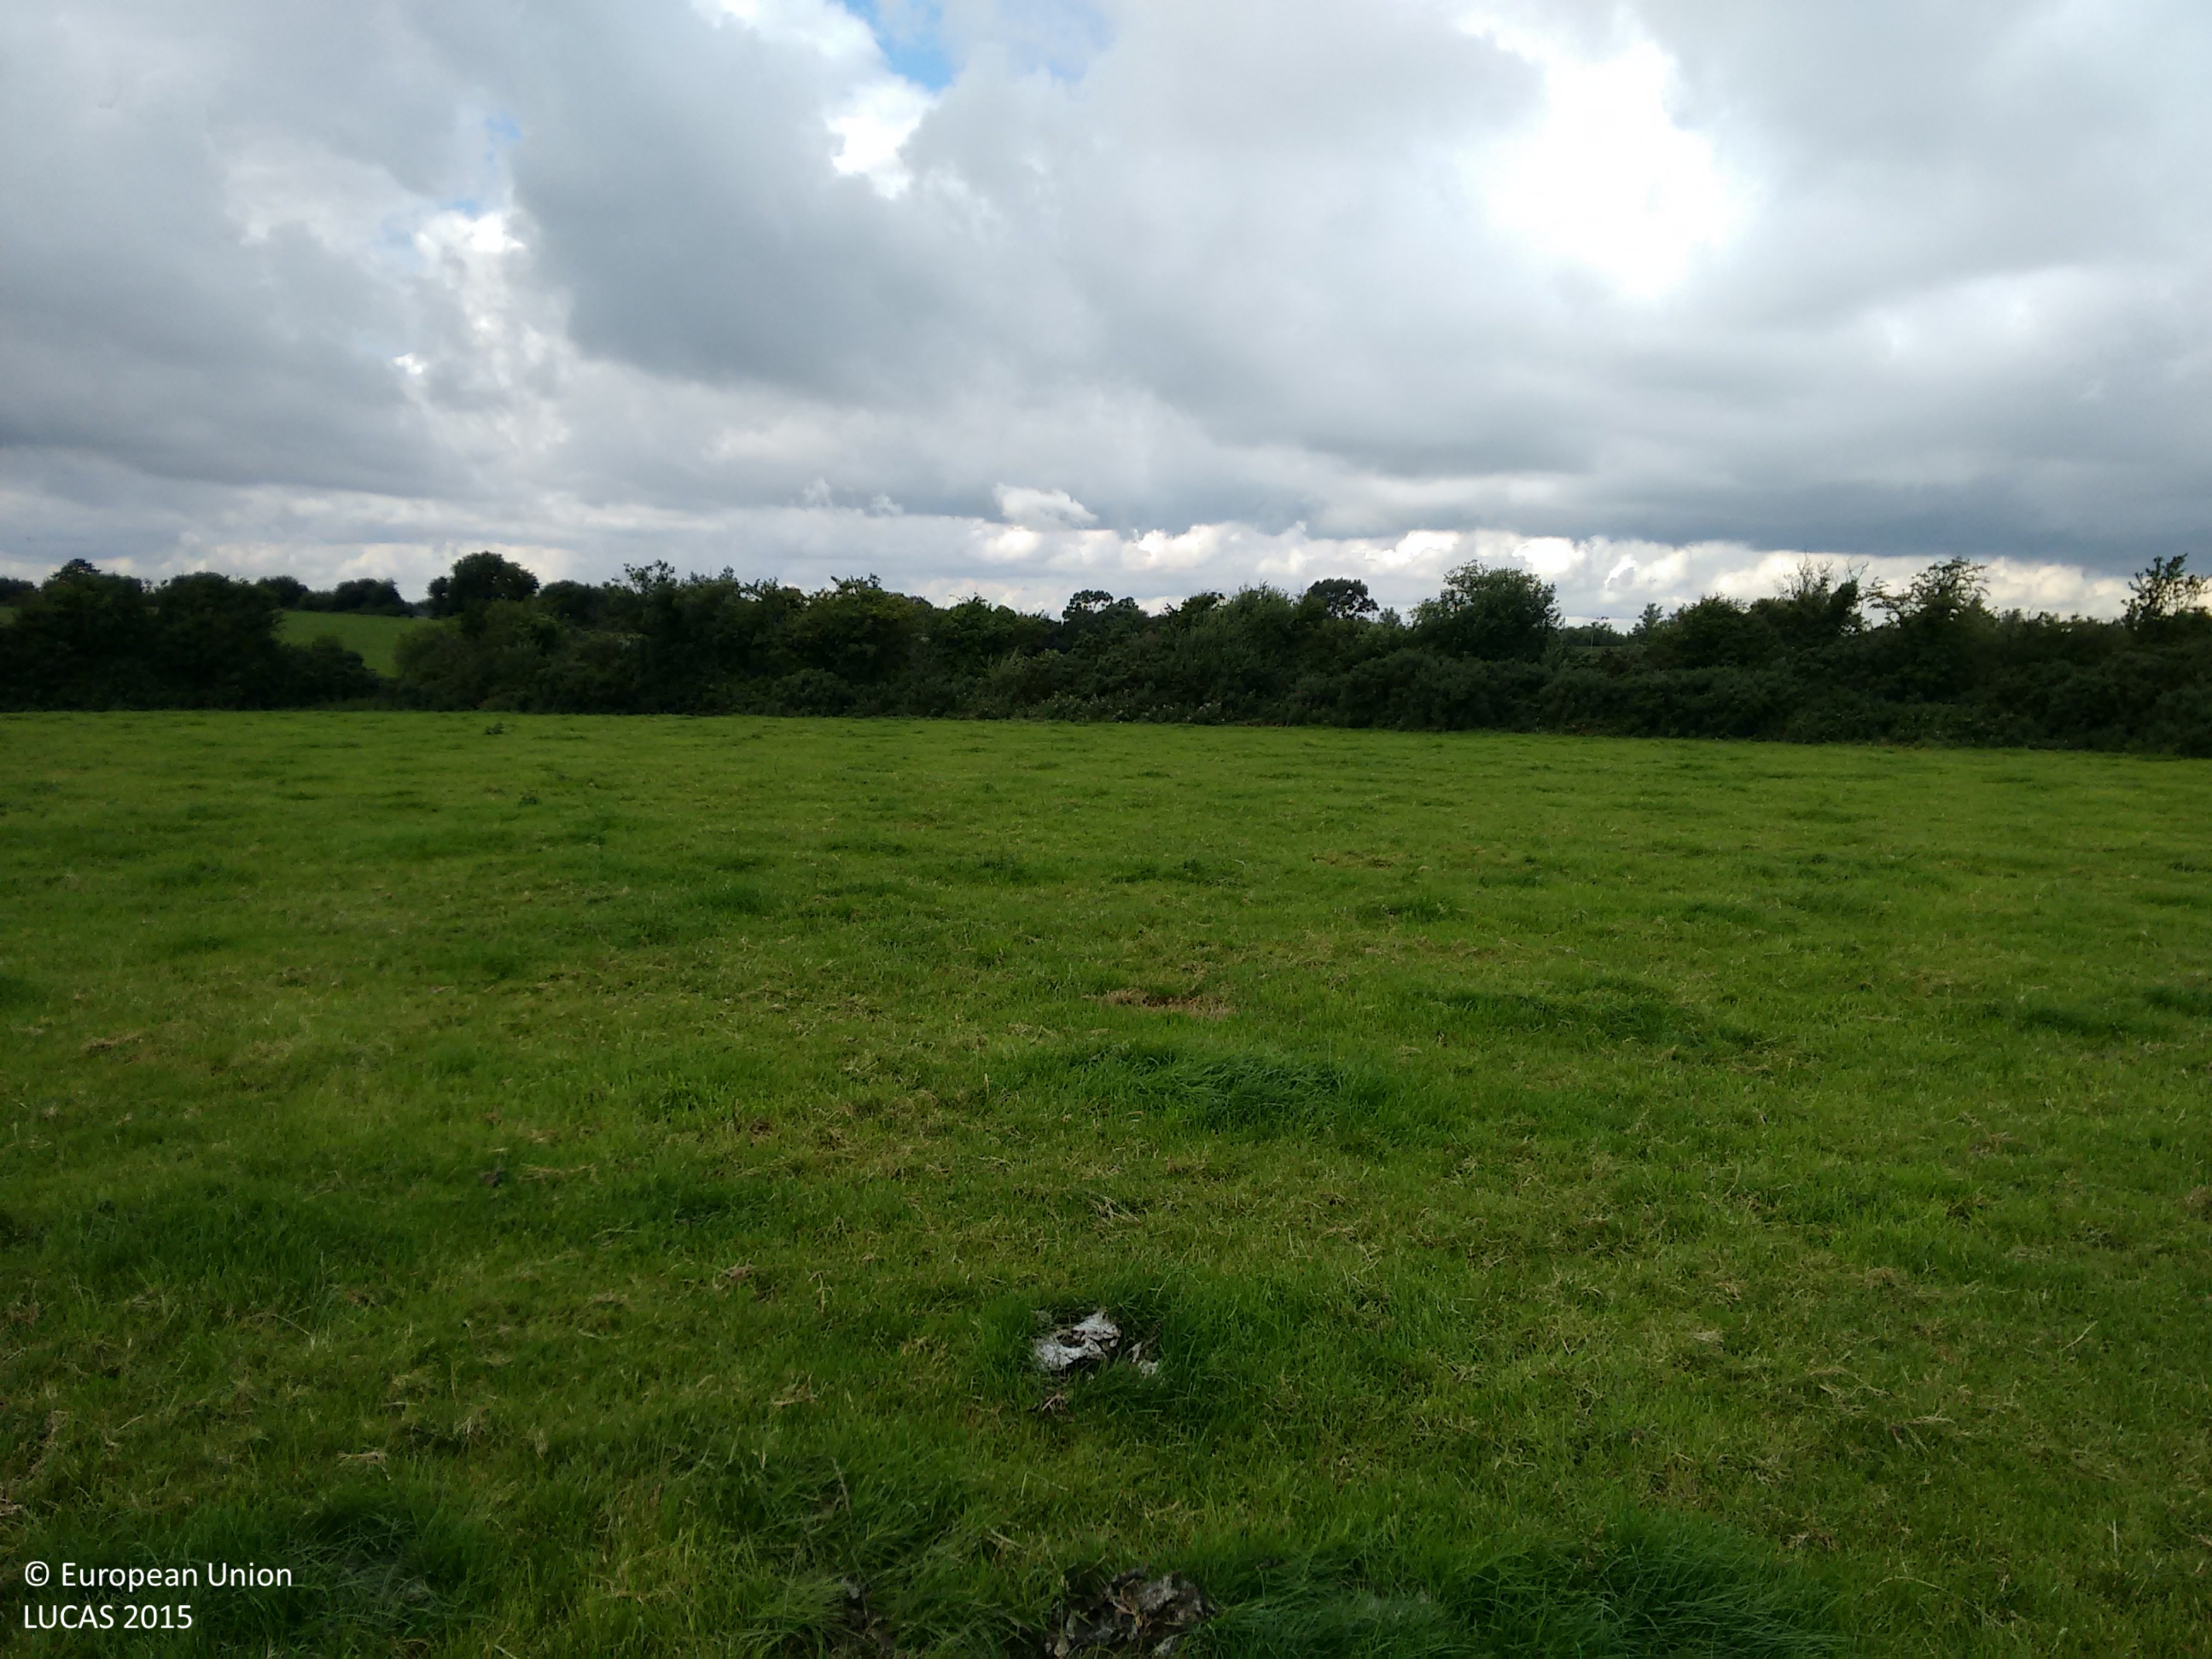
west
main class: Grassland
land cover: Grassland without tree/shrub cover
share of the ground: > 75 %
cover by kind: herbaceous plants 100 %
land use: Agriculture (excluding fallow land and kitchen gardens)
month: August
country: IE
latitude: 52.5520
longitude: -6.2400
